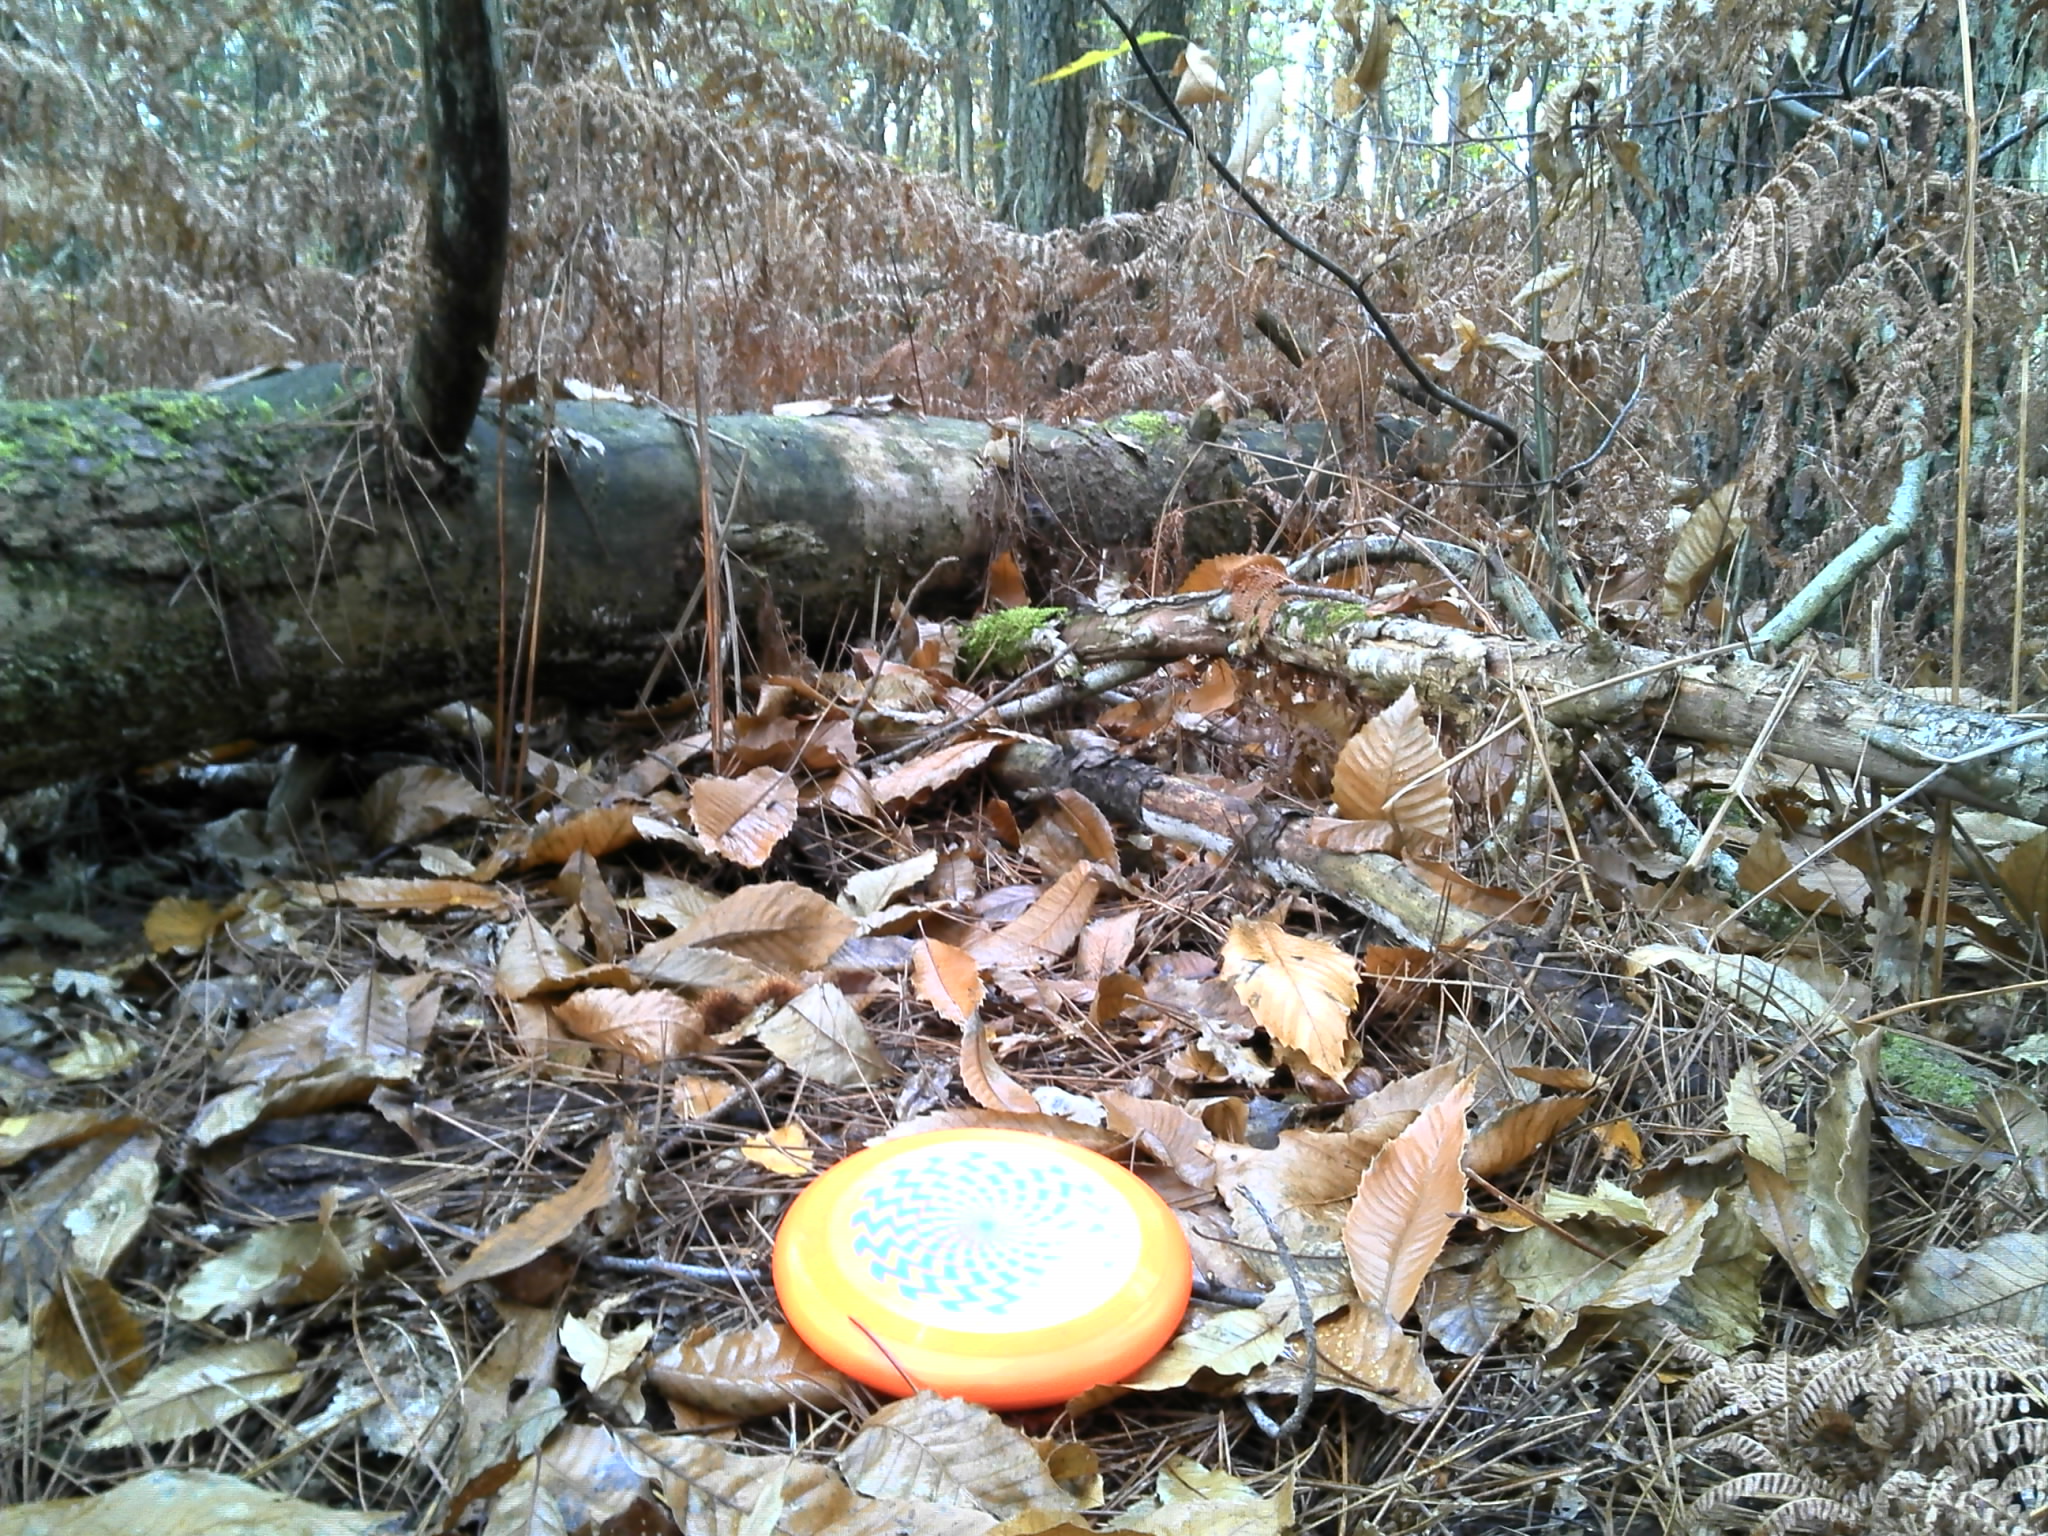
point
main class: Woodland
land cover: Pine dominated mixed woodland
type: hemiboreal forest and nemoral coniferous forest and mixed broadleaved-coniferous forest
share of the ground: > 75 %
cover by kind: broadleaved forest trees 65 %, coniferous forest trees 30 %, herbaceous plants 5 %
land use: Forestry
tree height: > 5 m
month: November
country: FR
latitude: 47.3537
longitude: 0.0328
